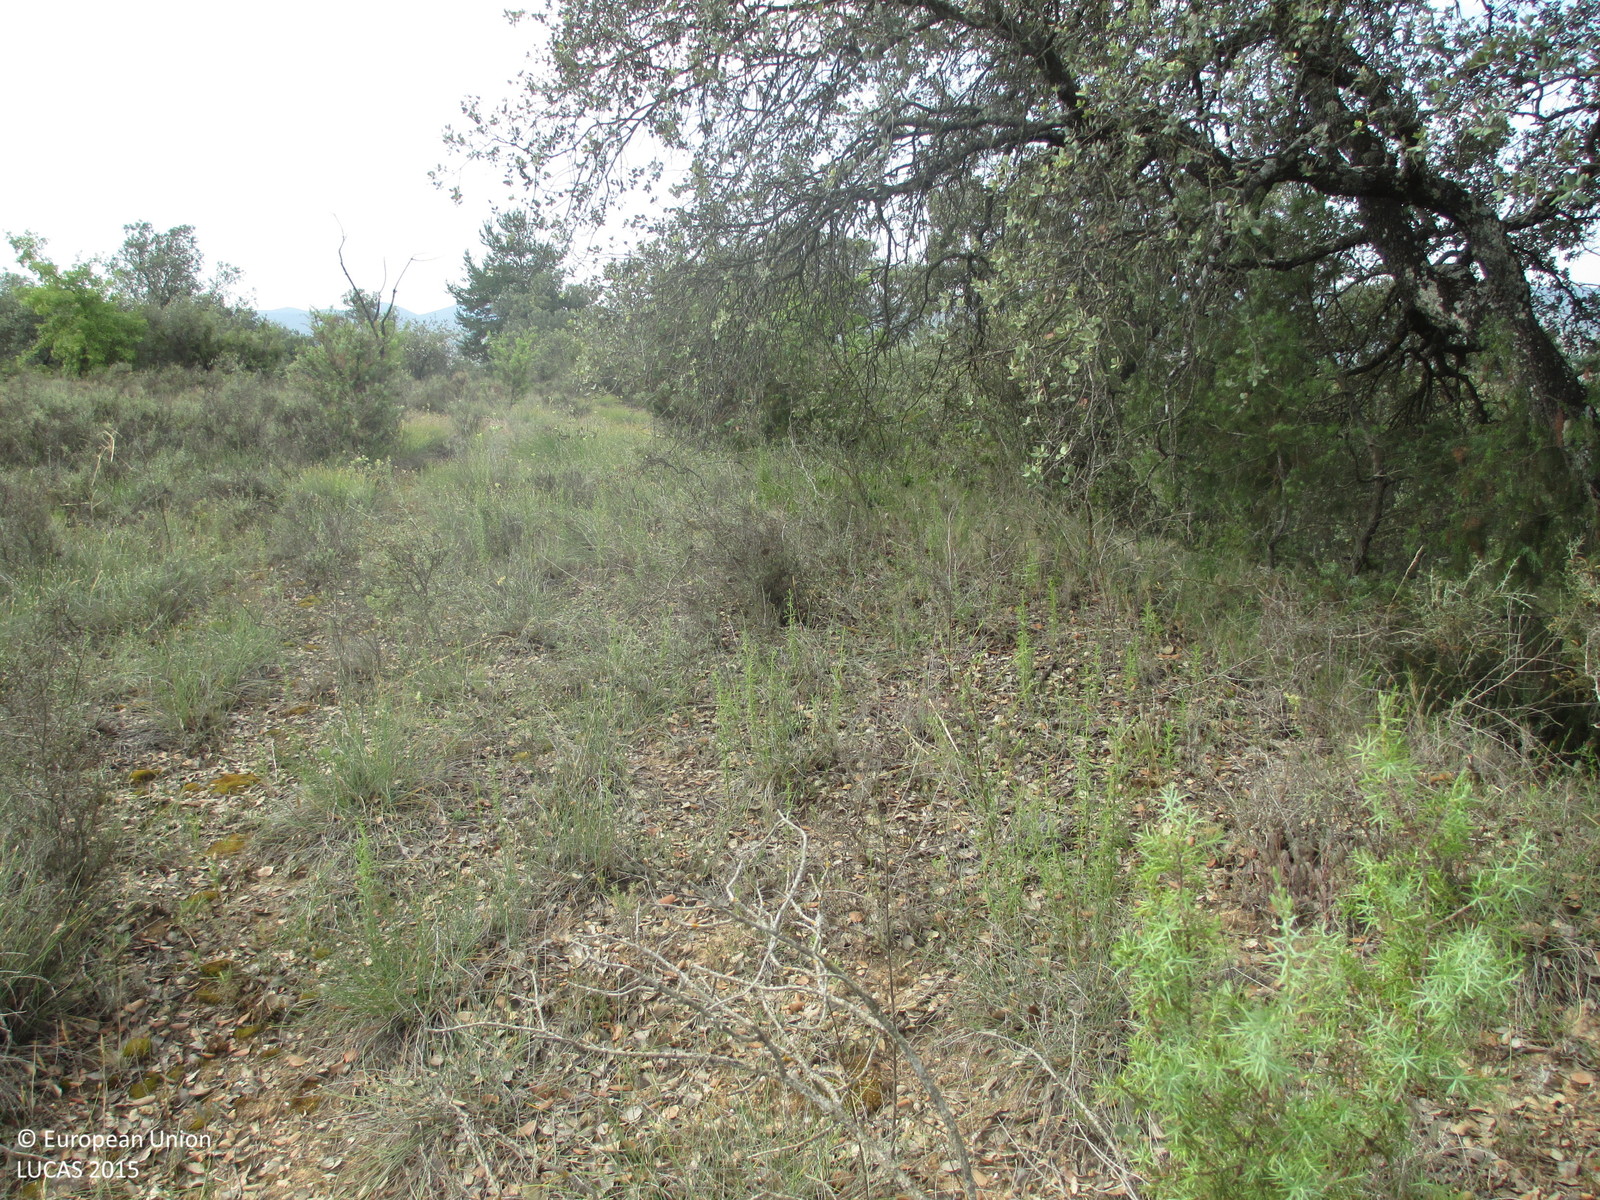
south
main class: Shrubland
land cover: Shrubland with sparse tree cover
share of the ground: > 75 %
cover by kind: shrubs 95 %, broadleaved forest trees 5 %
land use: Semi-natural and natural areas not in use
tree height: < 5 m
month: July
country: ES
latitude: 42.1390
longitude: 0.3634
